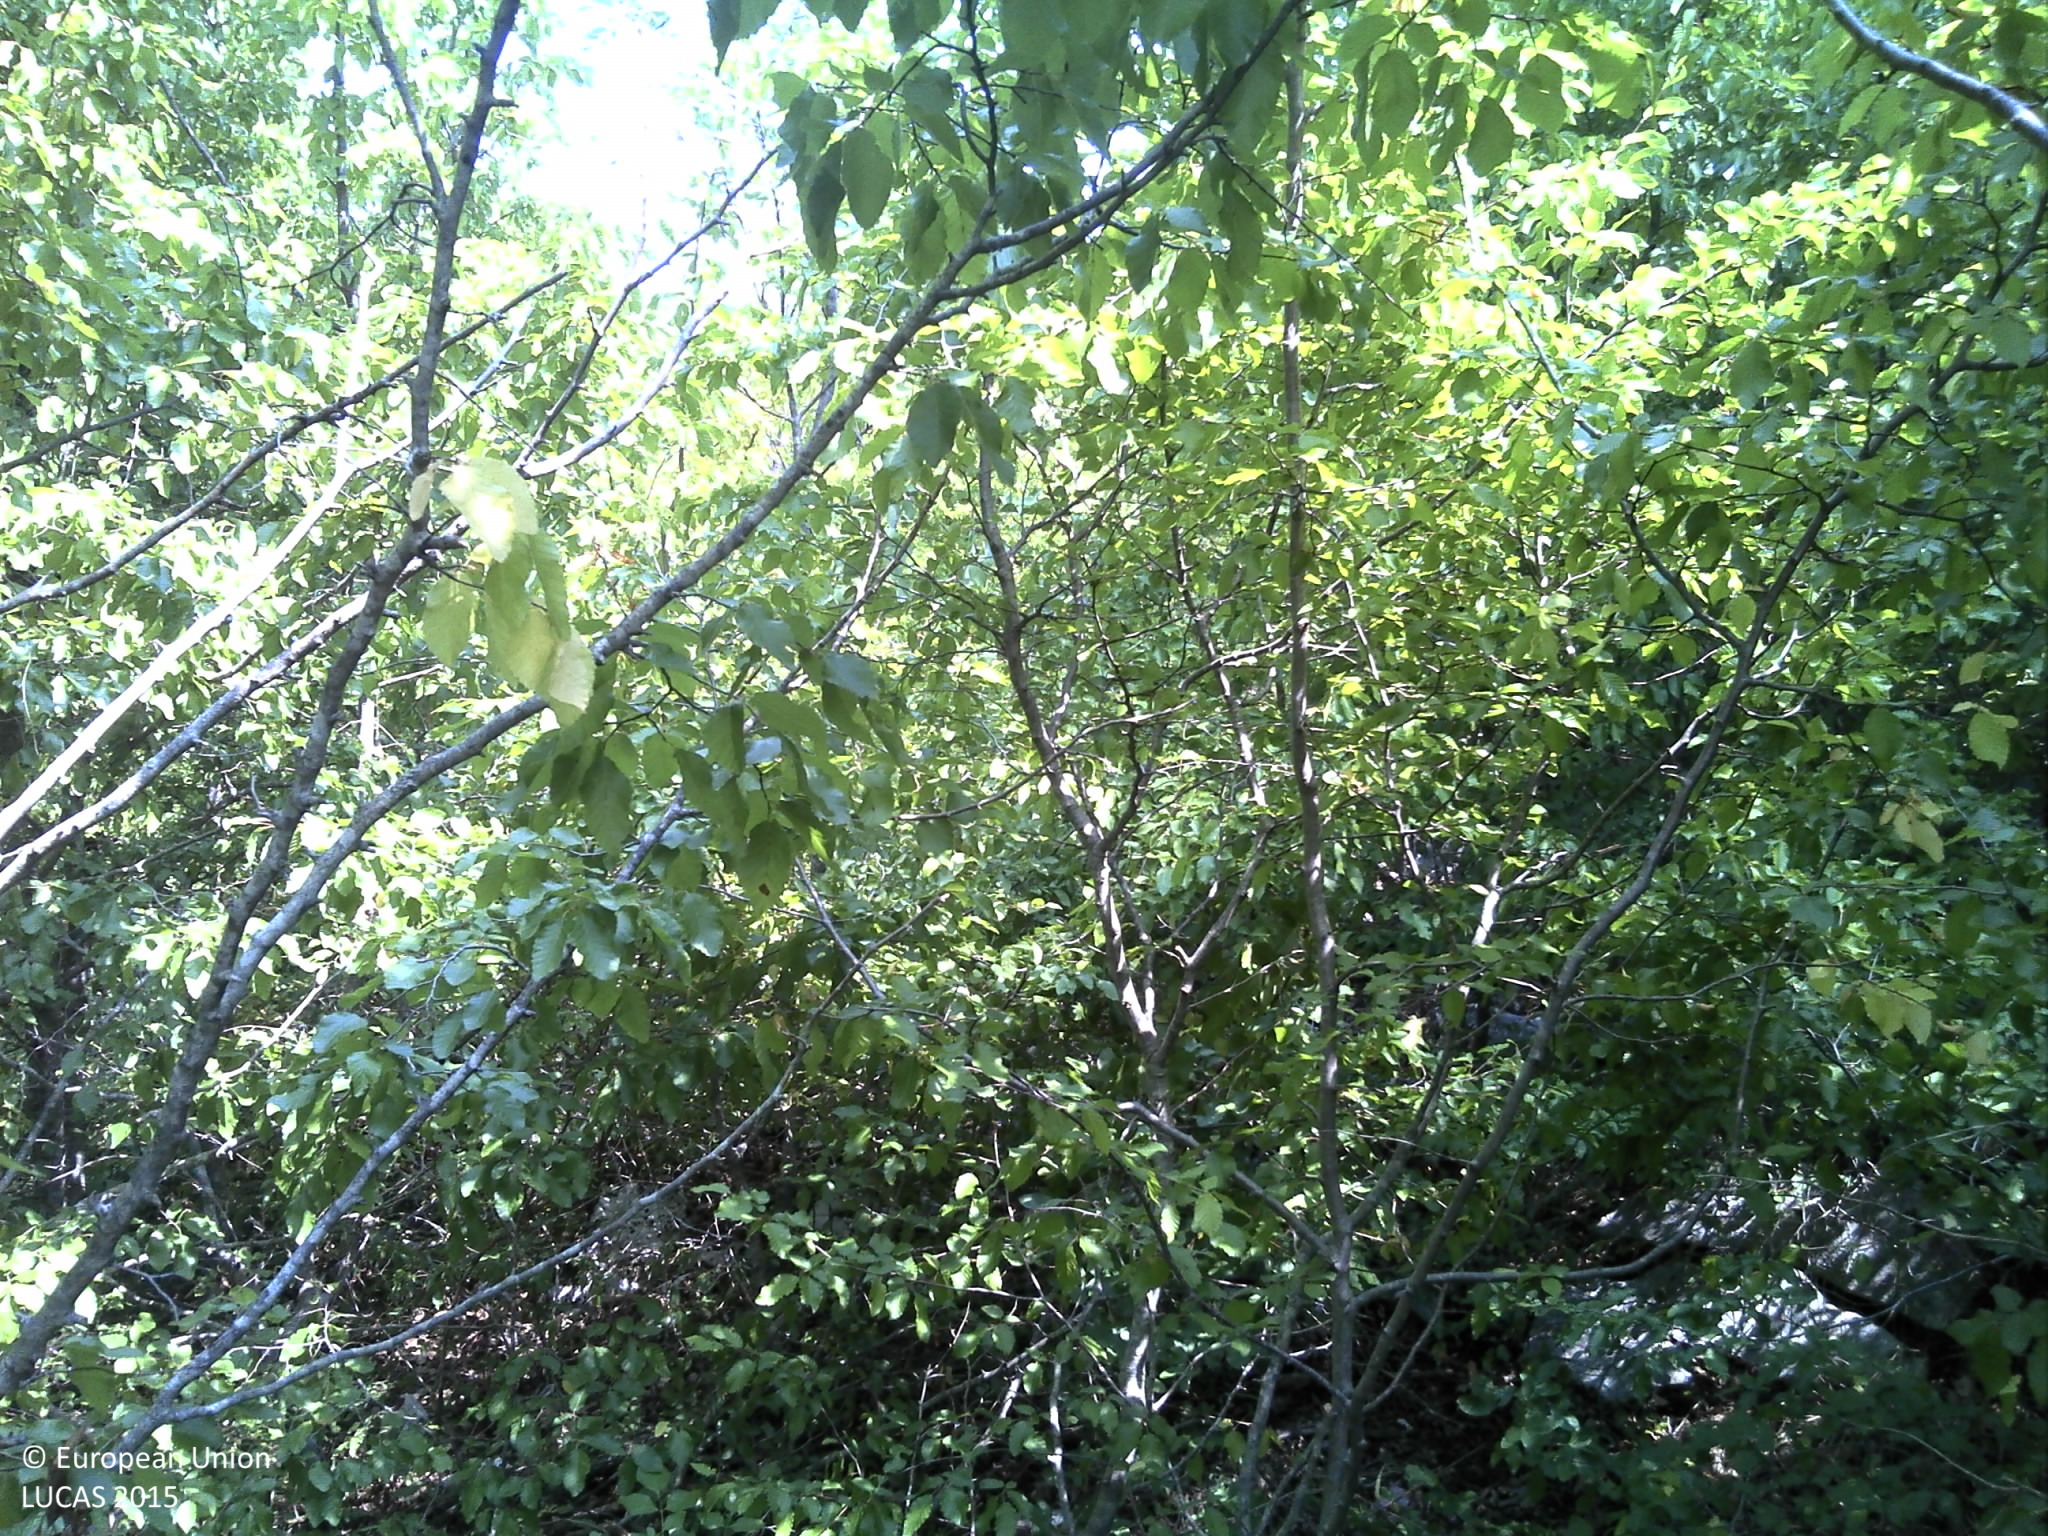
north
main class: Woodland
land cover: Broadleaved woodland
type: thermophilous deciduous forest
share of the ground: 50 - 75 %
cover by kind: broadleaved forest trees 65 %, shrubs 25 %, herbaceous plants 5 %, consolidated bare surface 5 %
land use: Semi-natural and natural areas not in use
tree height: > 5 m
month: July
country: HR
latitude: 43.5033
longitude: 16.9301
